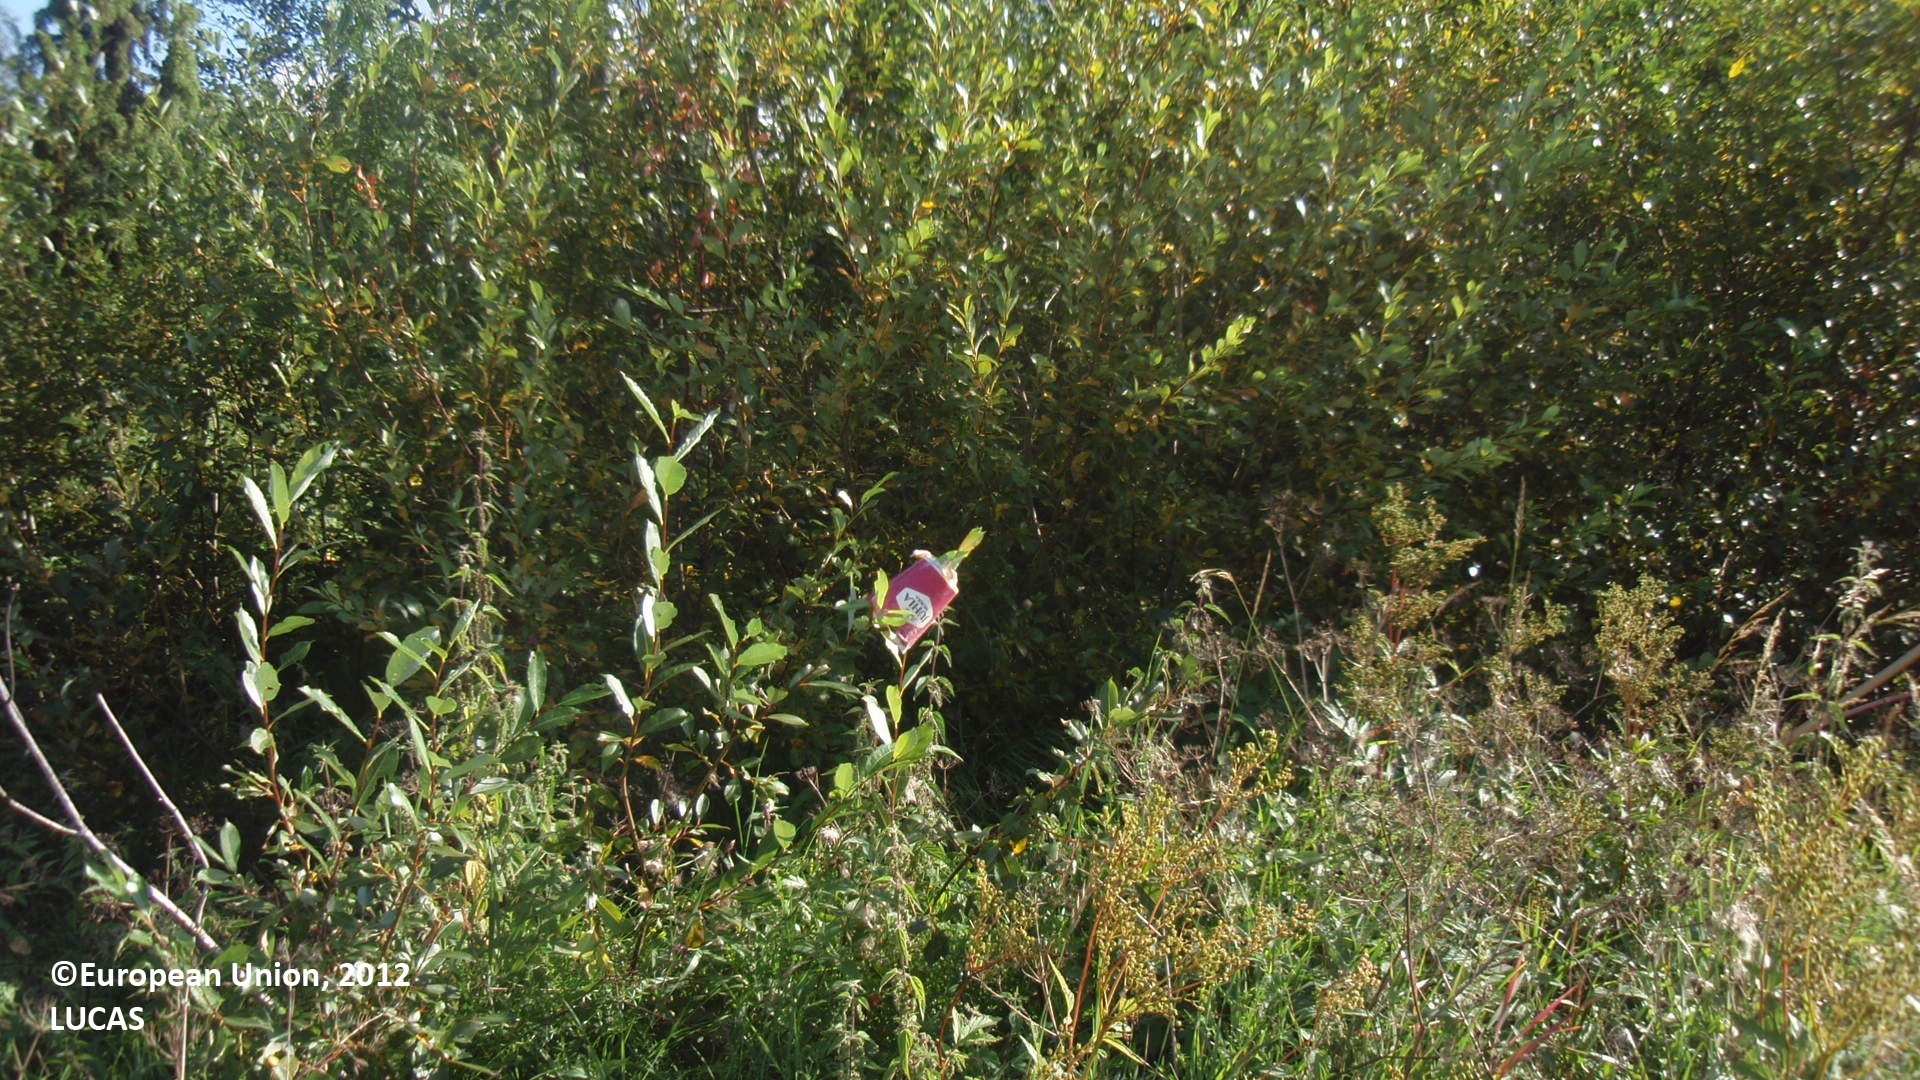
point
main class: Woodland
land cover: Broadleaved woodland
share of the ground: > 75 %
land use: Forestry
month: August
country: FI
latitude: 60.6368
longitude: 26.6690
